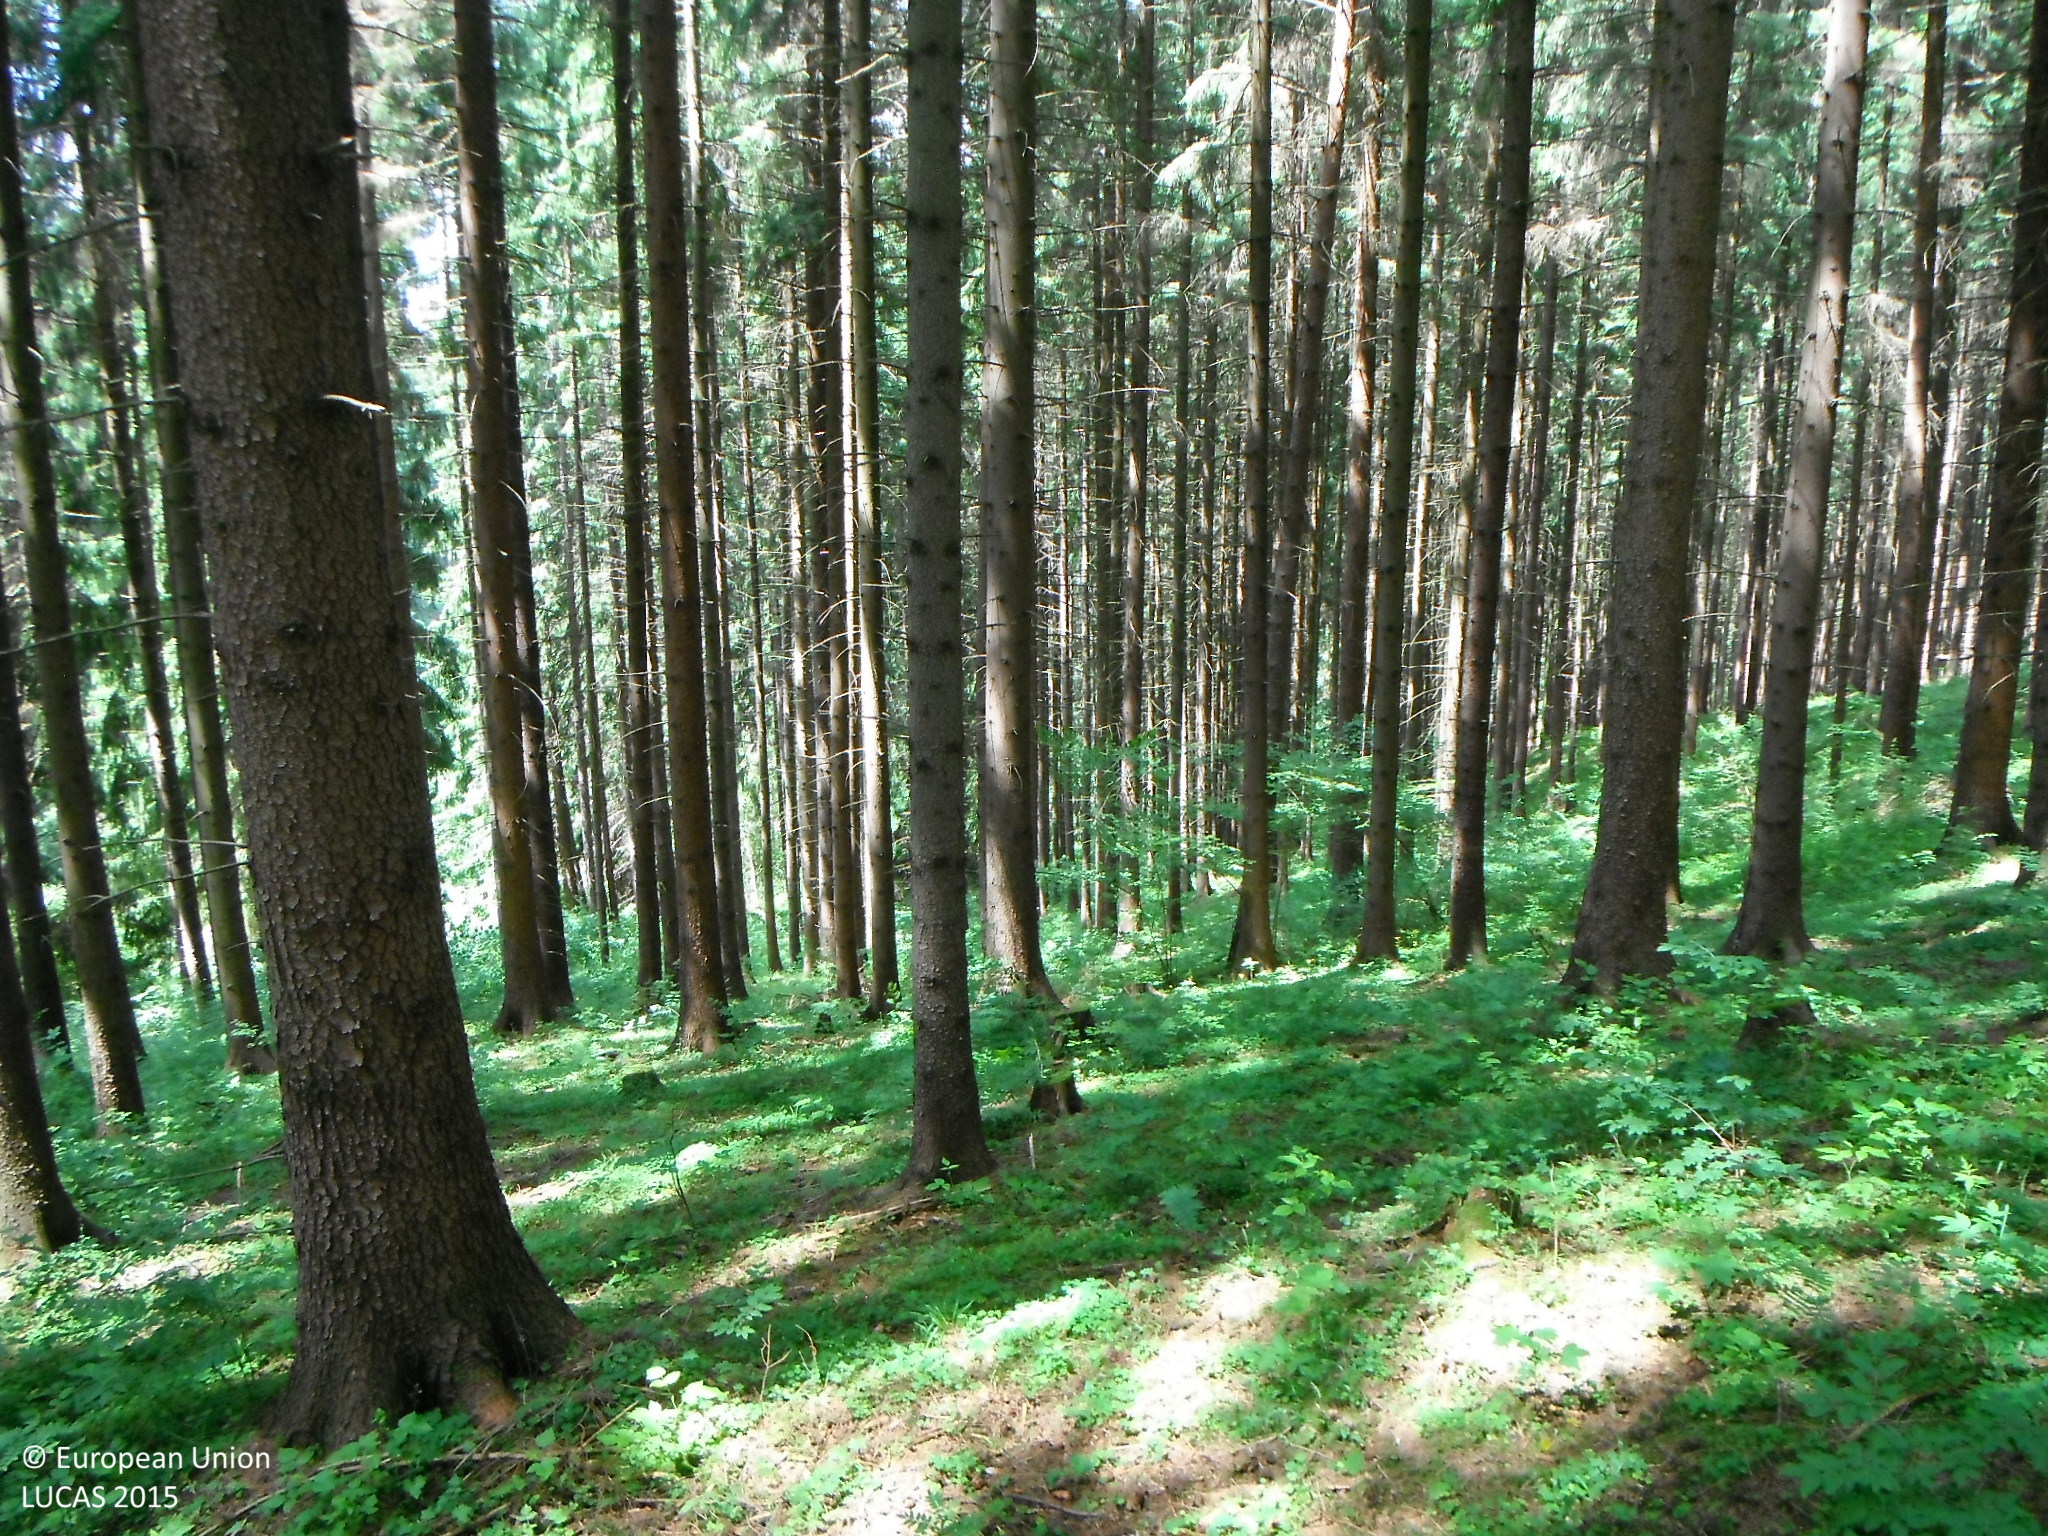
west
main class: Woodland
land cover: Spruce dominated coniferous woodland
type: alpine coniferous forest
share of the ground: > 75 %
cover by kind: coniferous forest trees 90 %, herbaceous plants 10 %
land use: Forestry
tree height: > 5 m
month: June
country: SK
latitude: 49.1890
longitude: 19.2860
